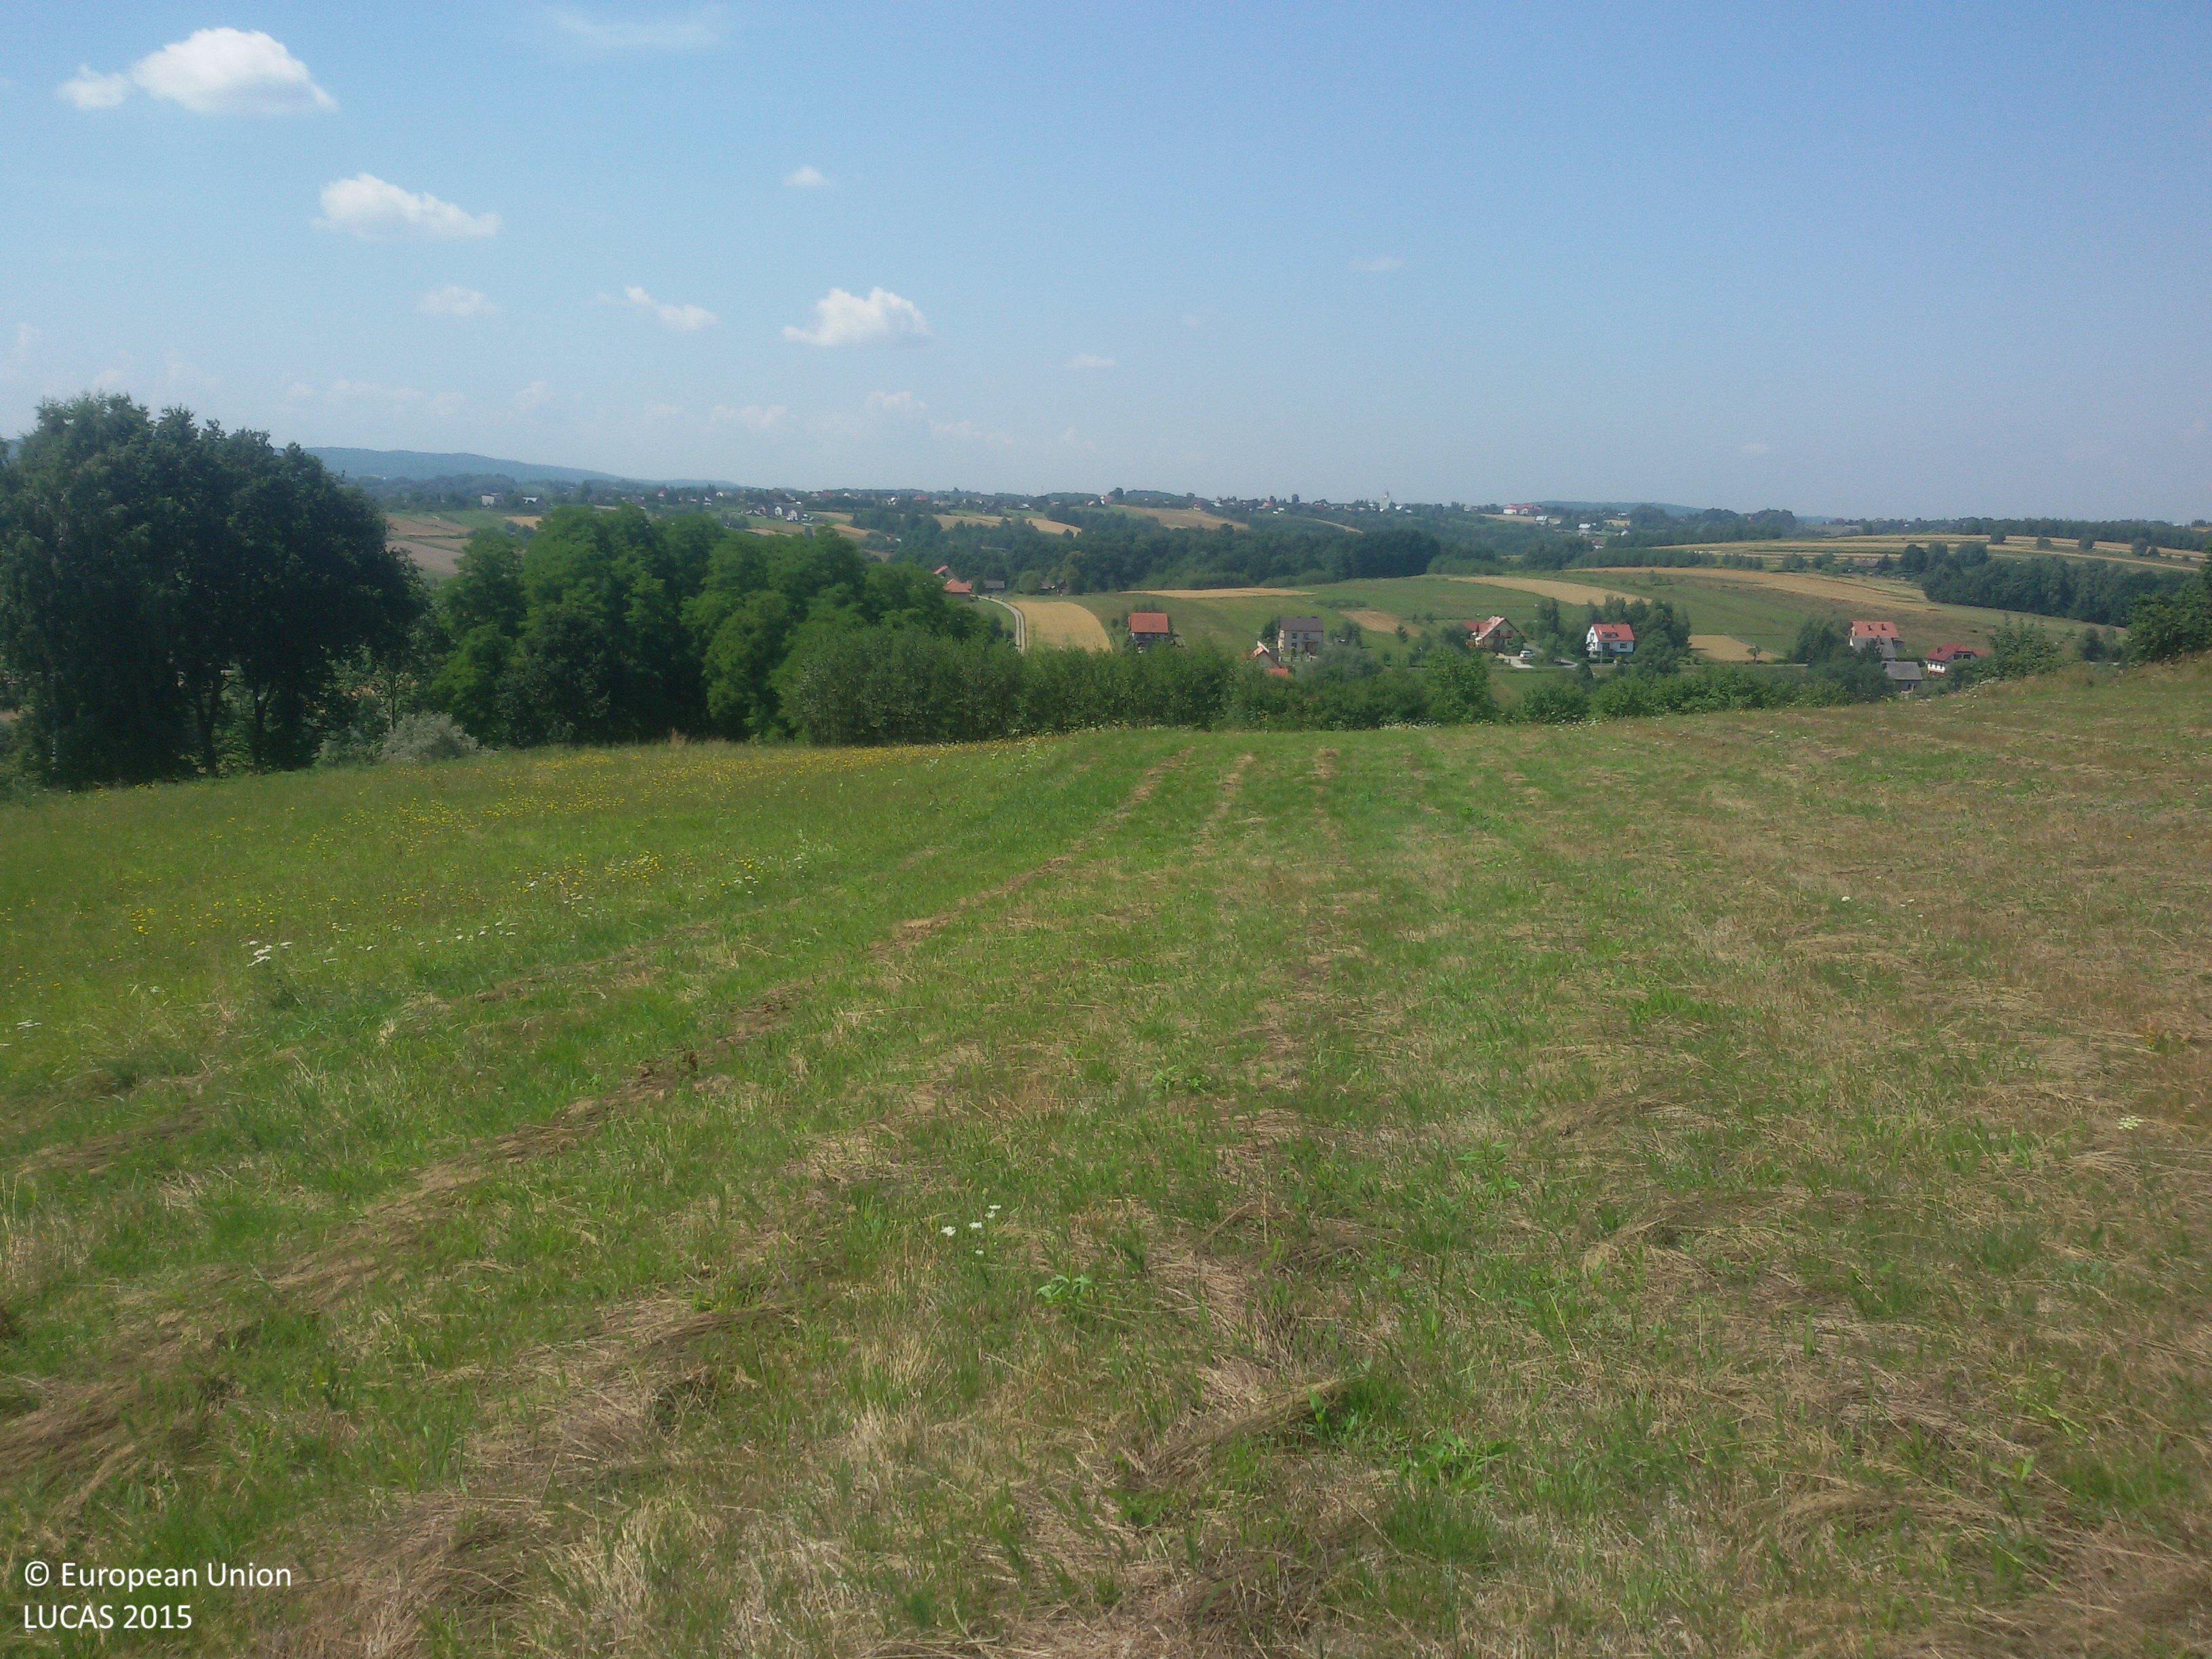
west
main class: Grassland
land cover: Grassland without tree/shrub cover
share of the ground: > 75 %
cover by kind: herbaceous plants 100 %
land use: Agriculture (excluding fallow land and kitchen gardens)
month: July
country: PL
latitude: 49.8801
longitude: 20.6857
